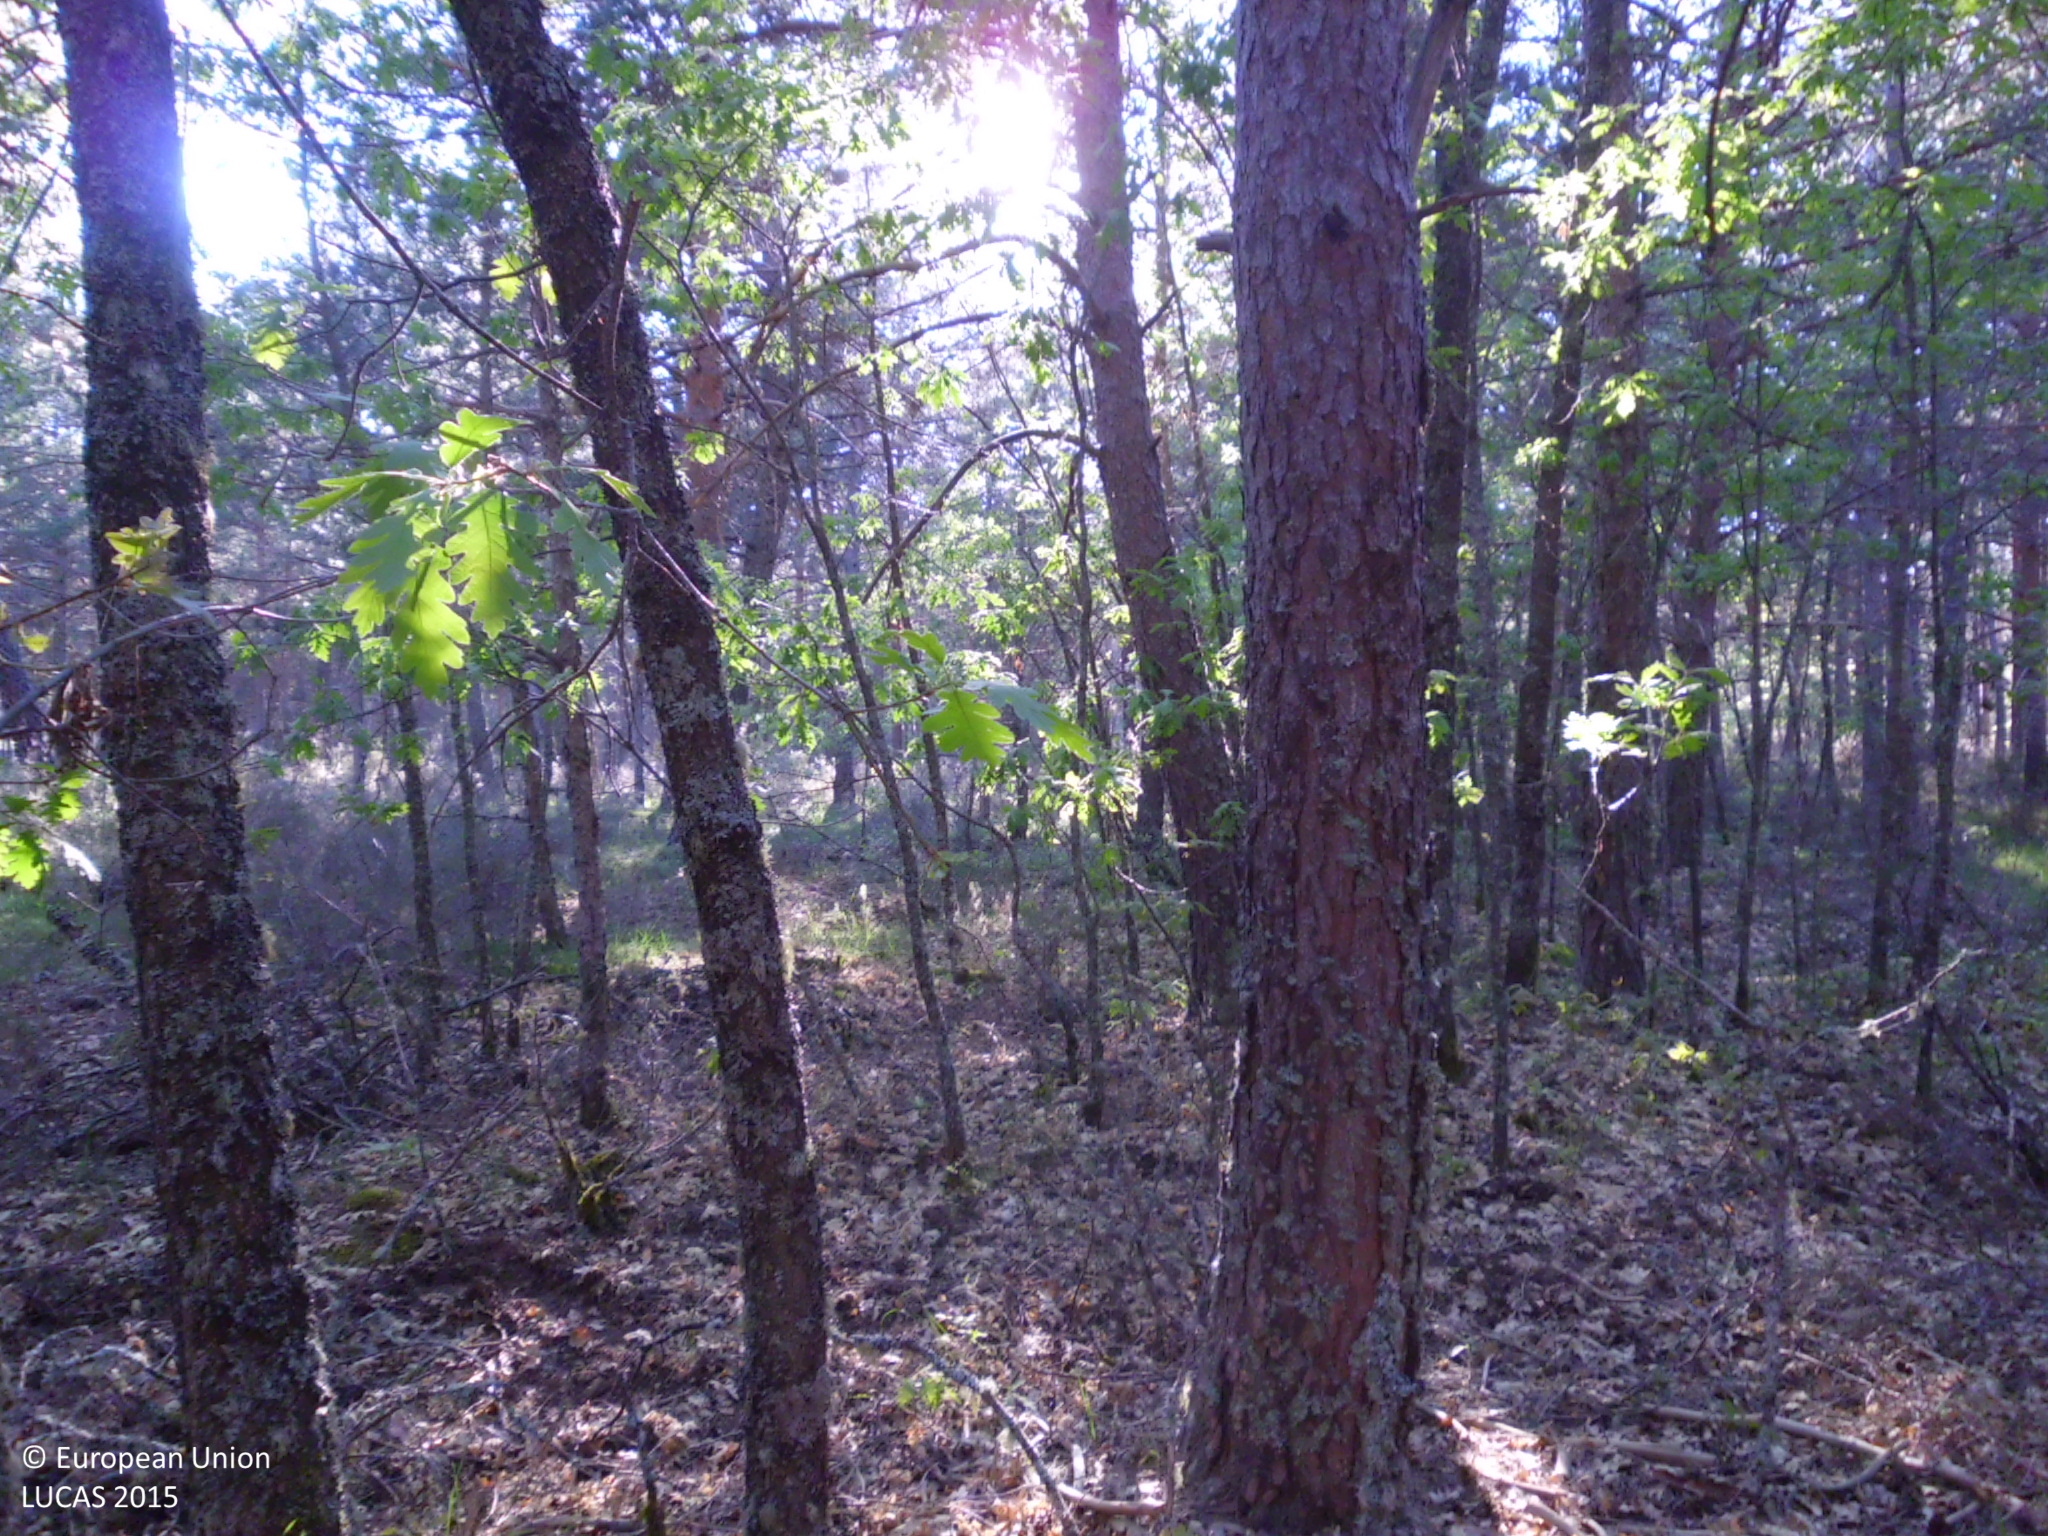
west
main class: Woodland
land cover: Pine dominated coniferous woodland
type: coniferous forest of the mediterranean region
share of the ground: > 75 %
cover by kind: coniferous forest trees 100 %
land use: Forestry
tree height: > 5 m
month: May
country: ES
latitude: 42.6866
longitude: -4.8643
